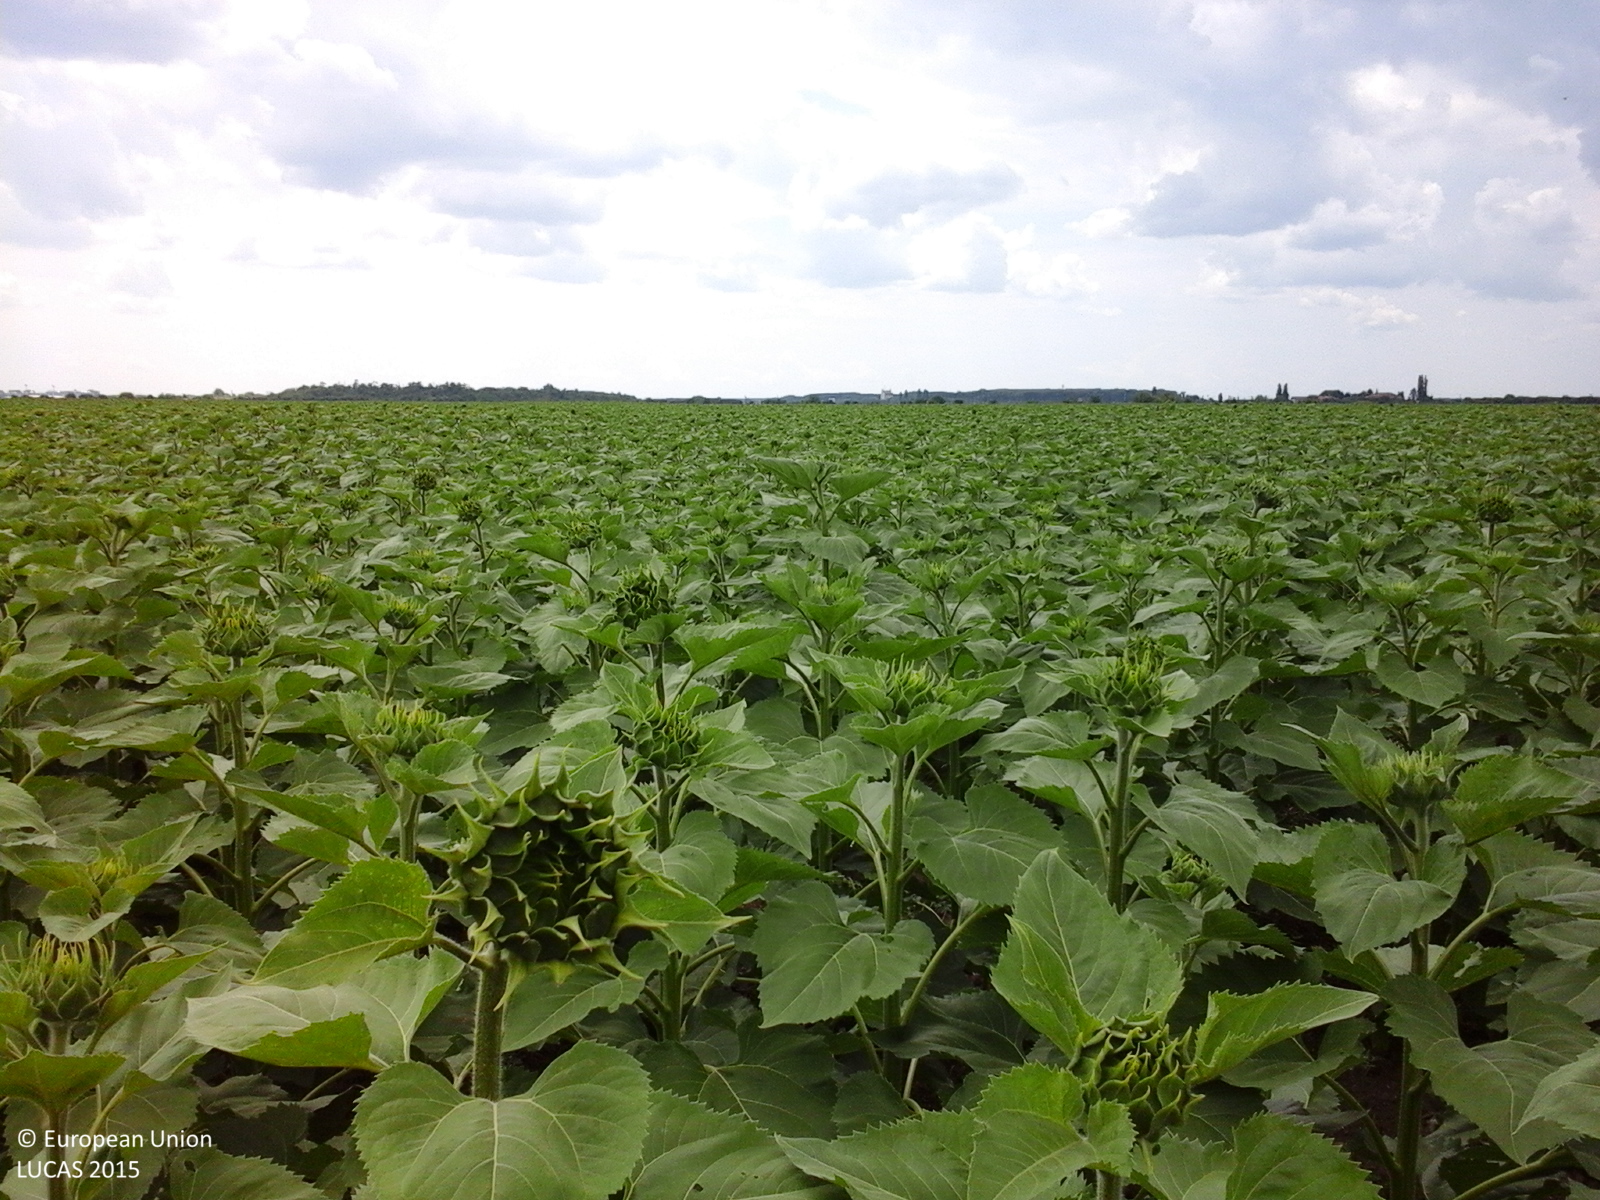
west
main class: Cropland
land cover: Sunflower
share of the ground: > 75 %
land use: Agriculture (excluding fallow land and kitchen gardens)
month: June
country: RO
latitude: 44.5866
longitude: 26.1160
